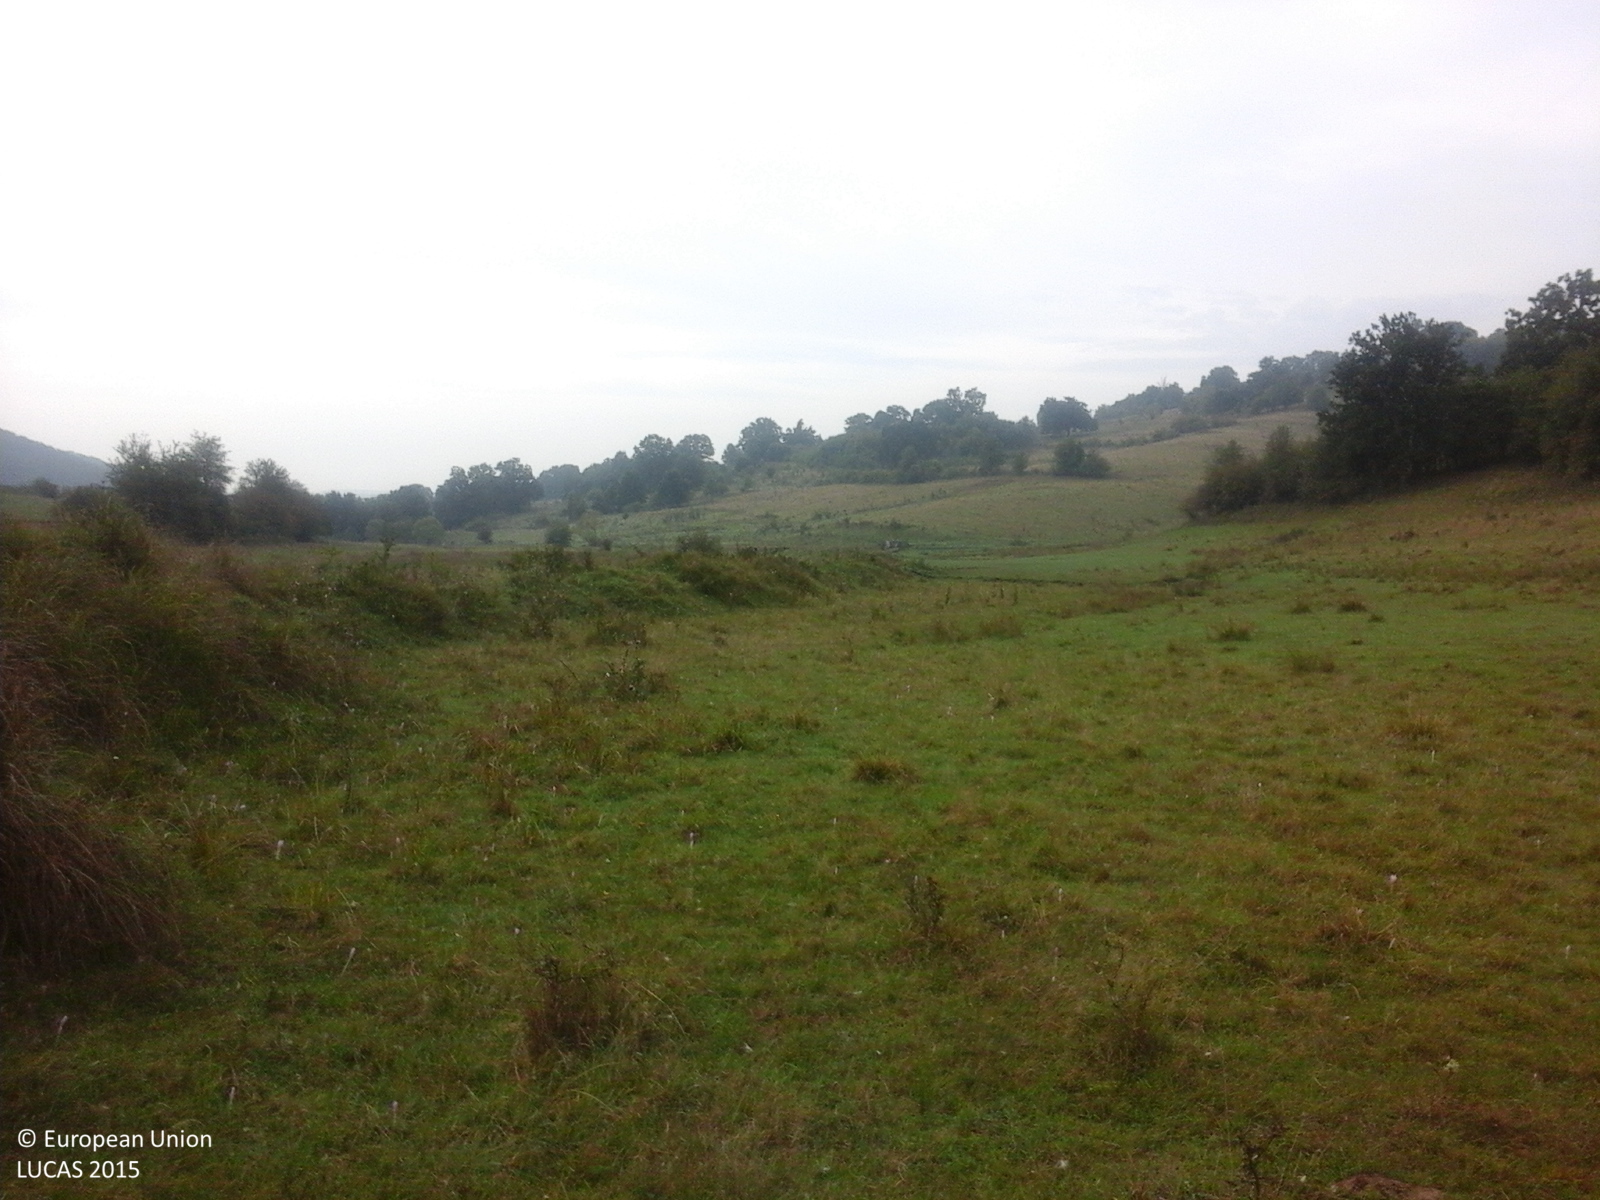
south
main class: Grassland
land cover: Spontaneously vegetated surfaces
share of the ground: > 75 %
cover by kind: herbaceous plants 100 %
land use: Agriculture (excluding fallow land and kitchen gardens)
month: September
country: RO
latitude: 46.9798
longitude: 23.1182
